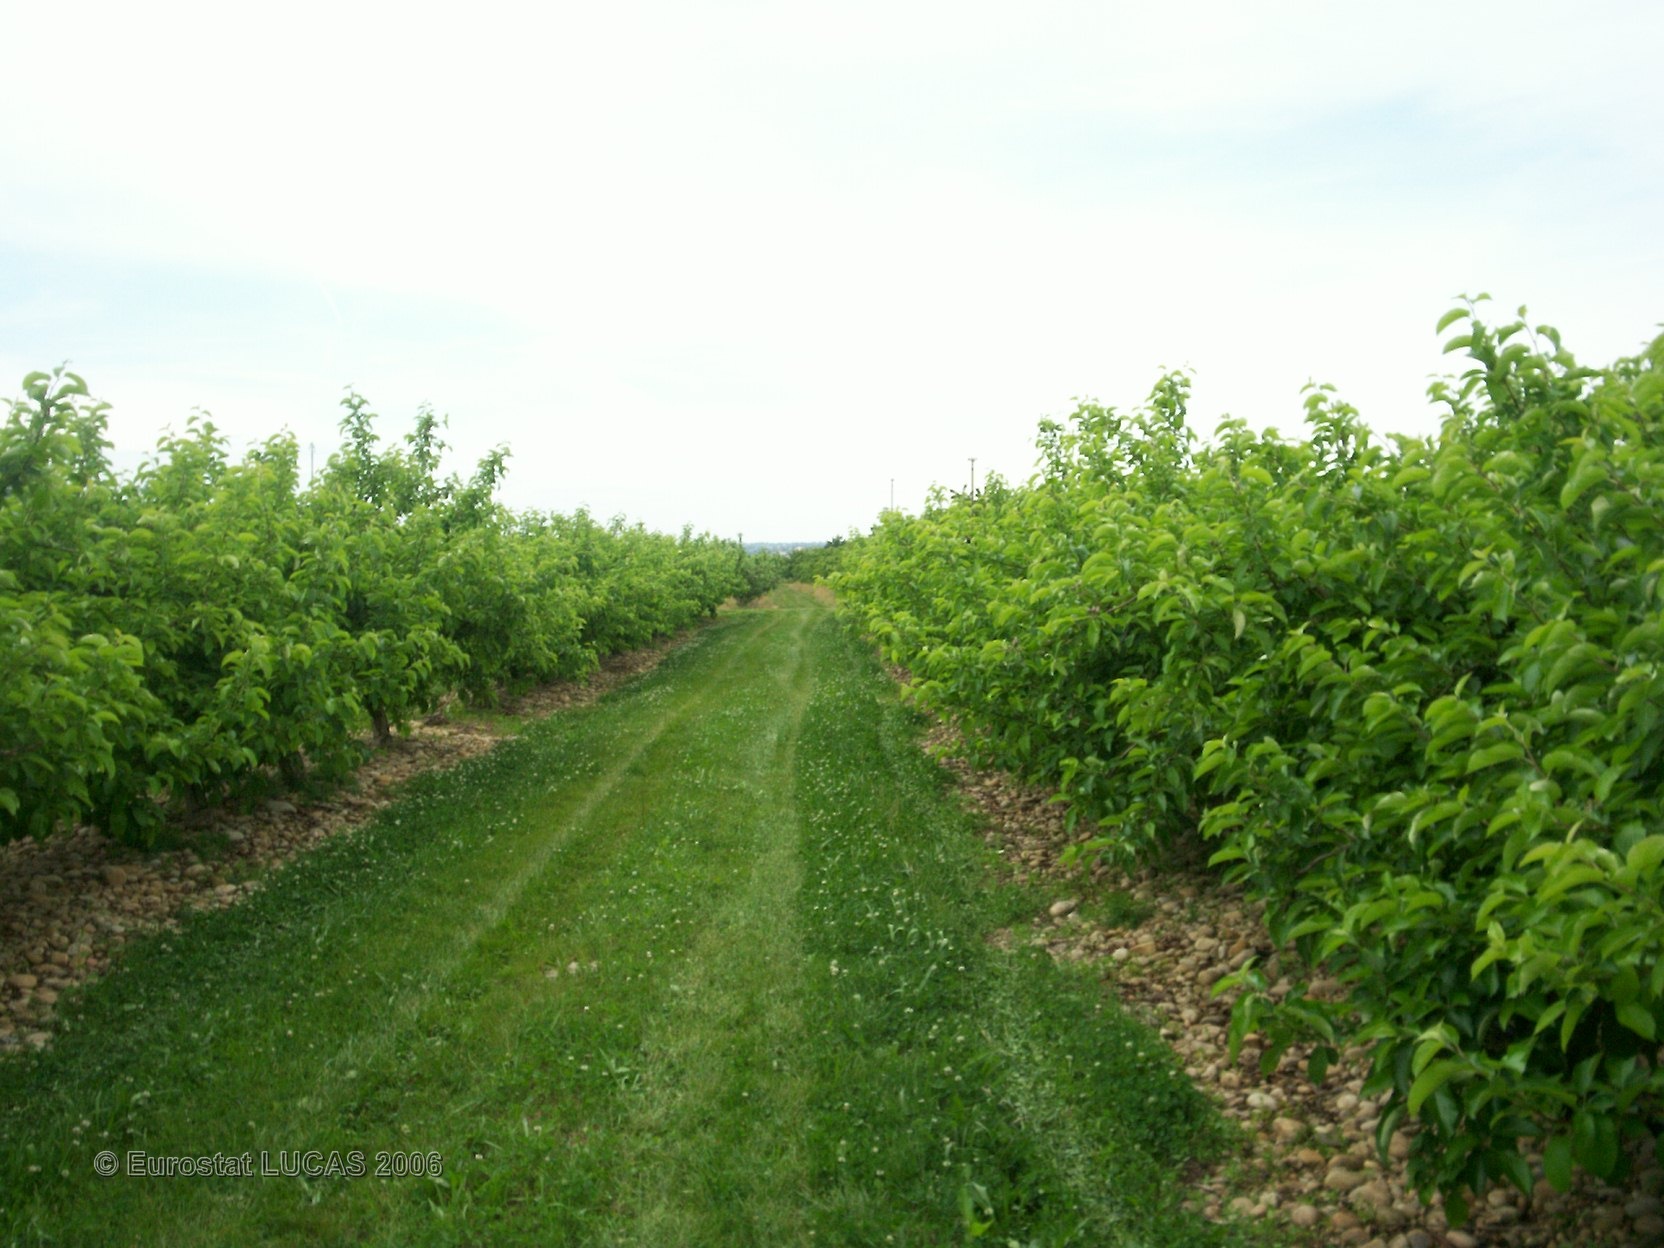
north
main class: Cropland
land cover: Pear fruit
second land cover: Grassland with sparse tree/shrub cover
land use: Agriculture (excluding fallow land and kitchen gardens)
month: May
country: FR
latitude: 45.6450
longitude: 4.7560
